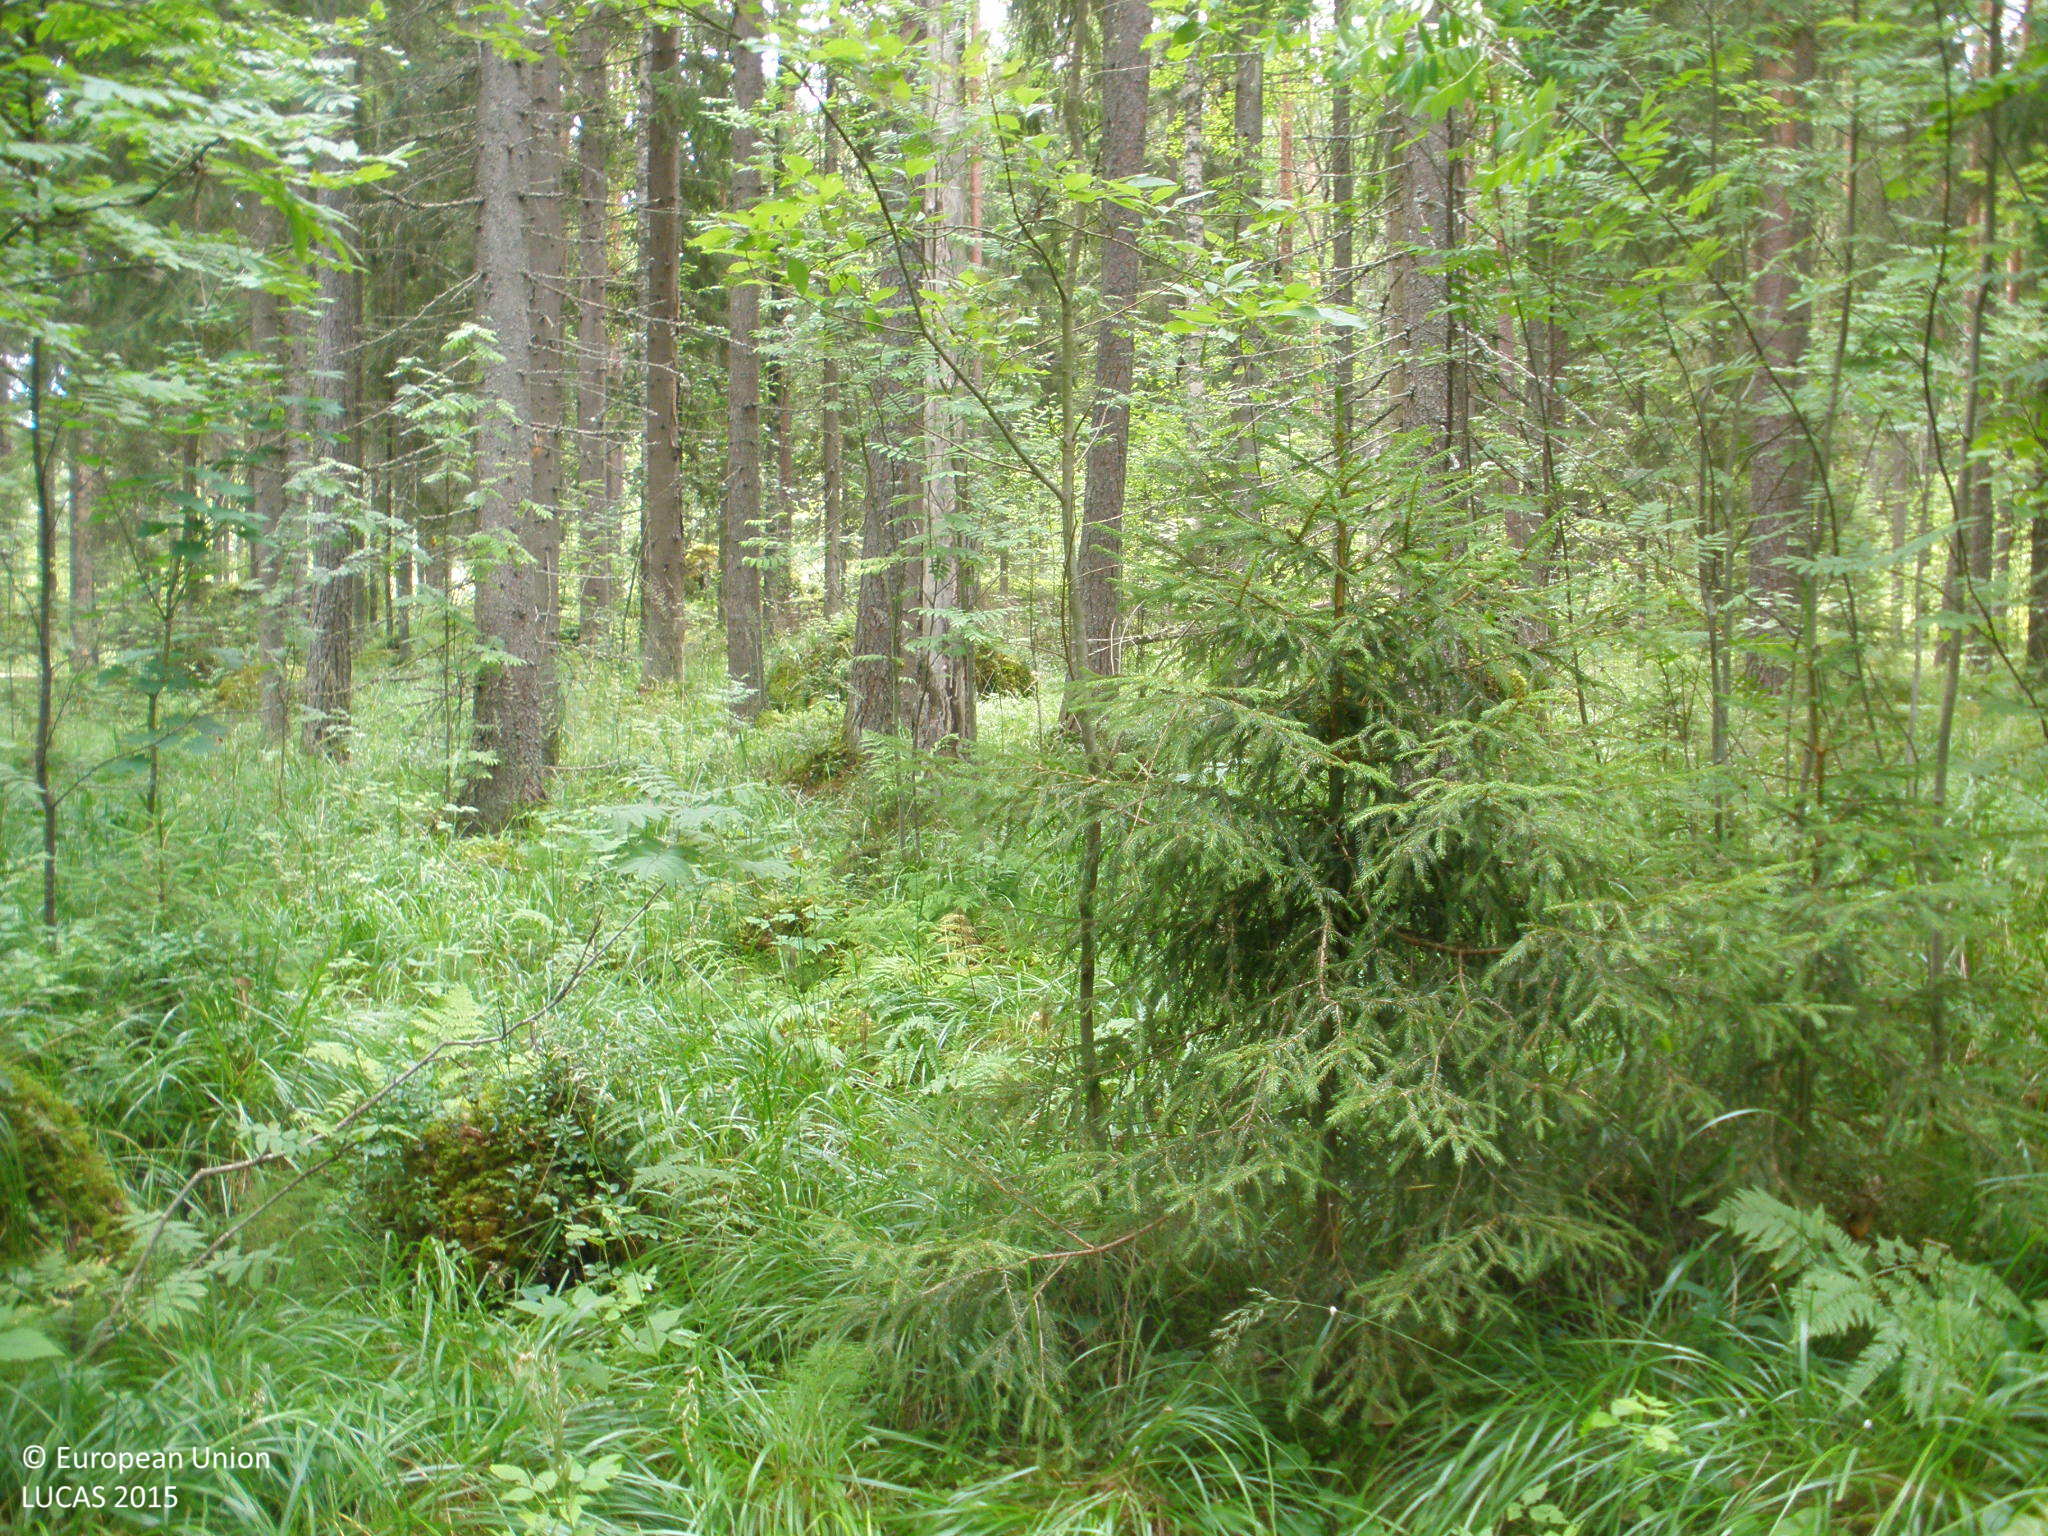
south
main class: Woodland
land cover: Spruce dominated mixed woodland
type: boreal forest
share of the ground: > 75 %
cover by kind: coniferous forest trees 60 %, broadleaved forest trees 25 %, herbaceous plants 10 %, lichens and mosses 5 %
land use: Forestry
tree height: > 5 m
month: July
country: FI
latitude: 61.3686
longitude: 24.7151
